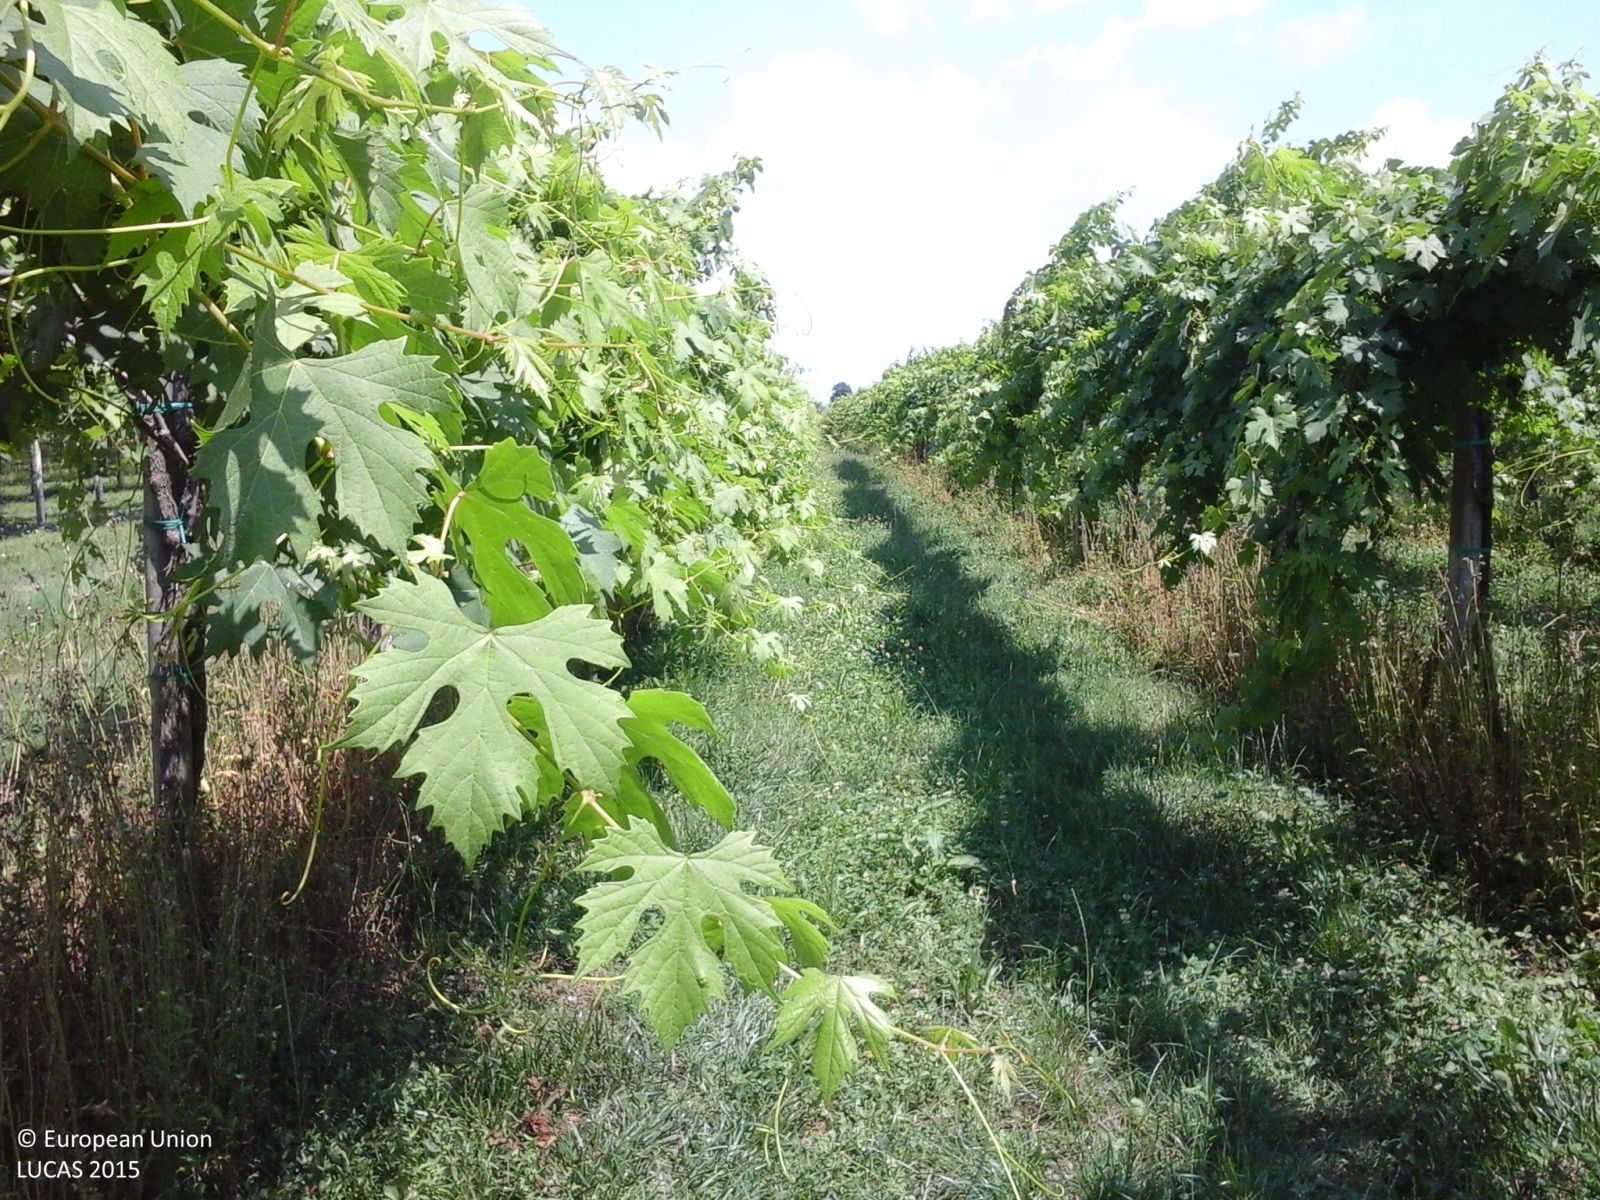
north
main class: Cropland
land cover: Vineyards
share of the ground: 50 - 75 %
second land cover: Grassland without tree/shrub cover
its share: > 75 %
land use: Agriculture (excluding fallow land and kitchen gardens)
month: June
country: IT
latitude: 44.6907
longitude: 10.7177
